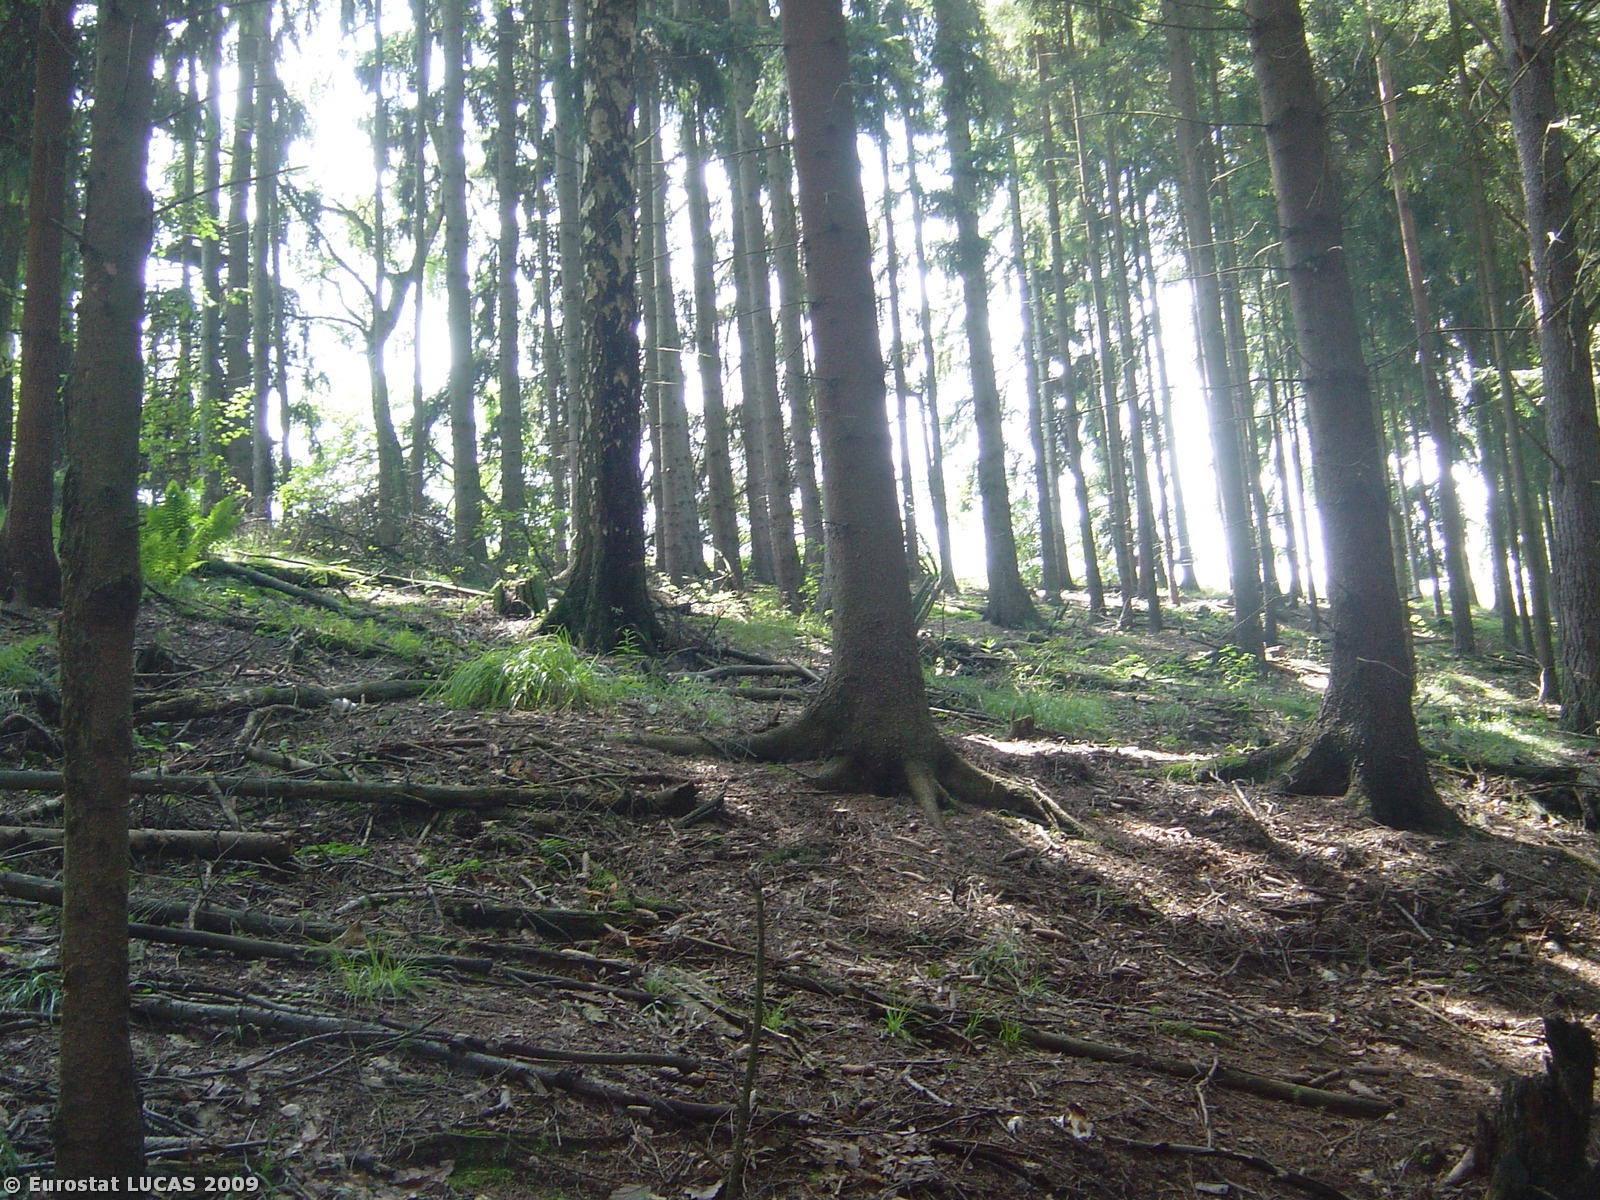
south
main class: Woodland
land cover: Coniferous woodland
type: hemiboreal forest and nemoral coniferous forest and mixed broadleaved-coniferous forest
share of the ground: > 75 %
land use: Forestry
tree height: > 5 m
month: July
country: CZ
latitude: 49.8952
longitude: 12.9093
